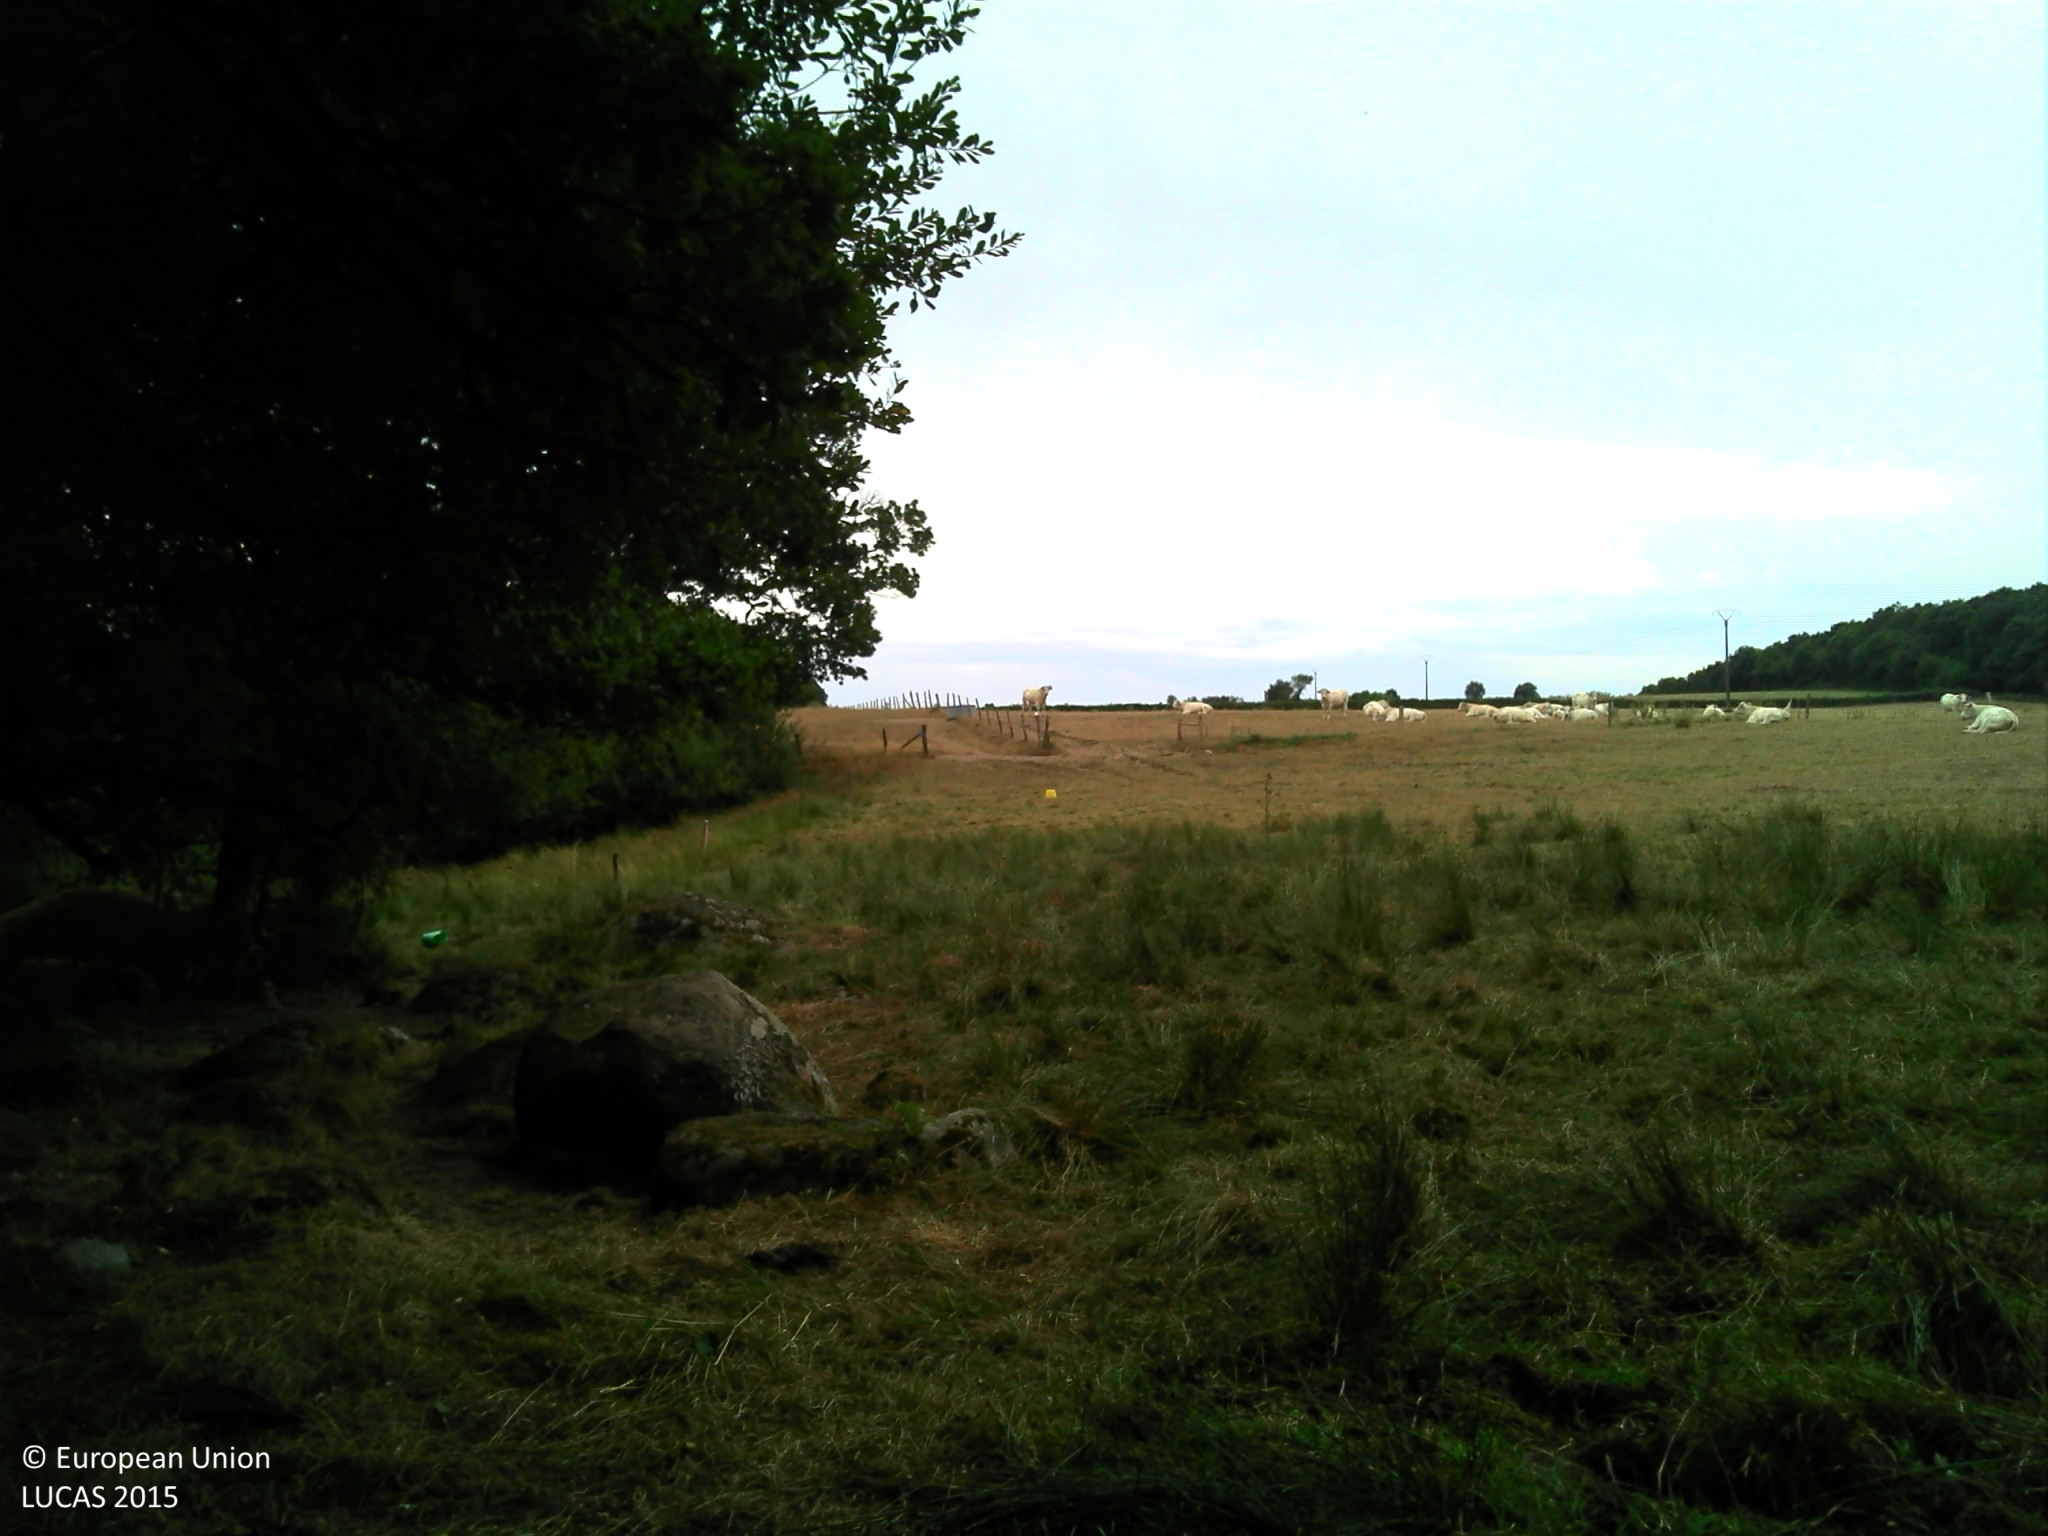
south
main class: Grassland
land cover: Grassland without tree/shrub cover
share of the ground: > 75 %
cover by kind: herbaceous plants 100 %
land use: Agriculture (excluding fallow land and kitchen gardens)
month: July
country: FR
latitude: 46.5806
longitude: 2.8320
